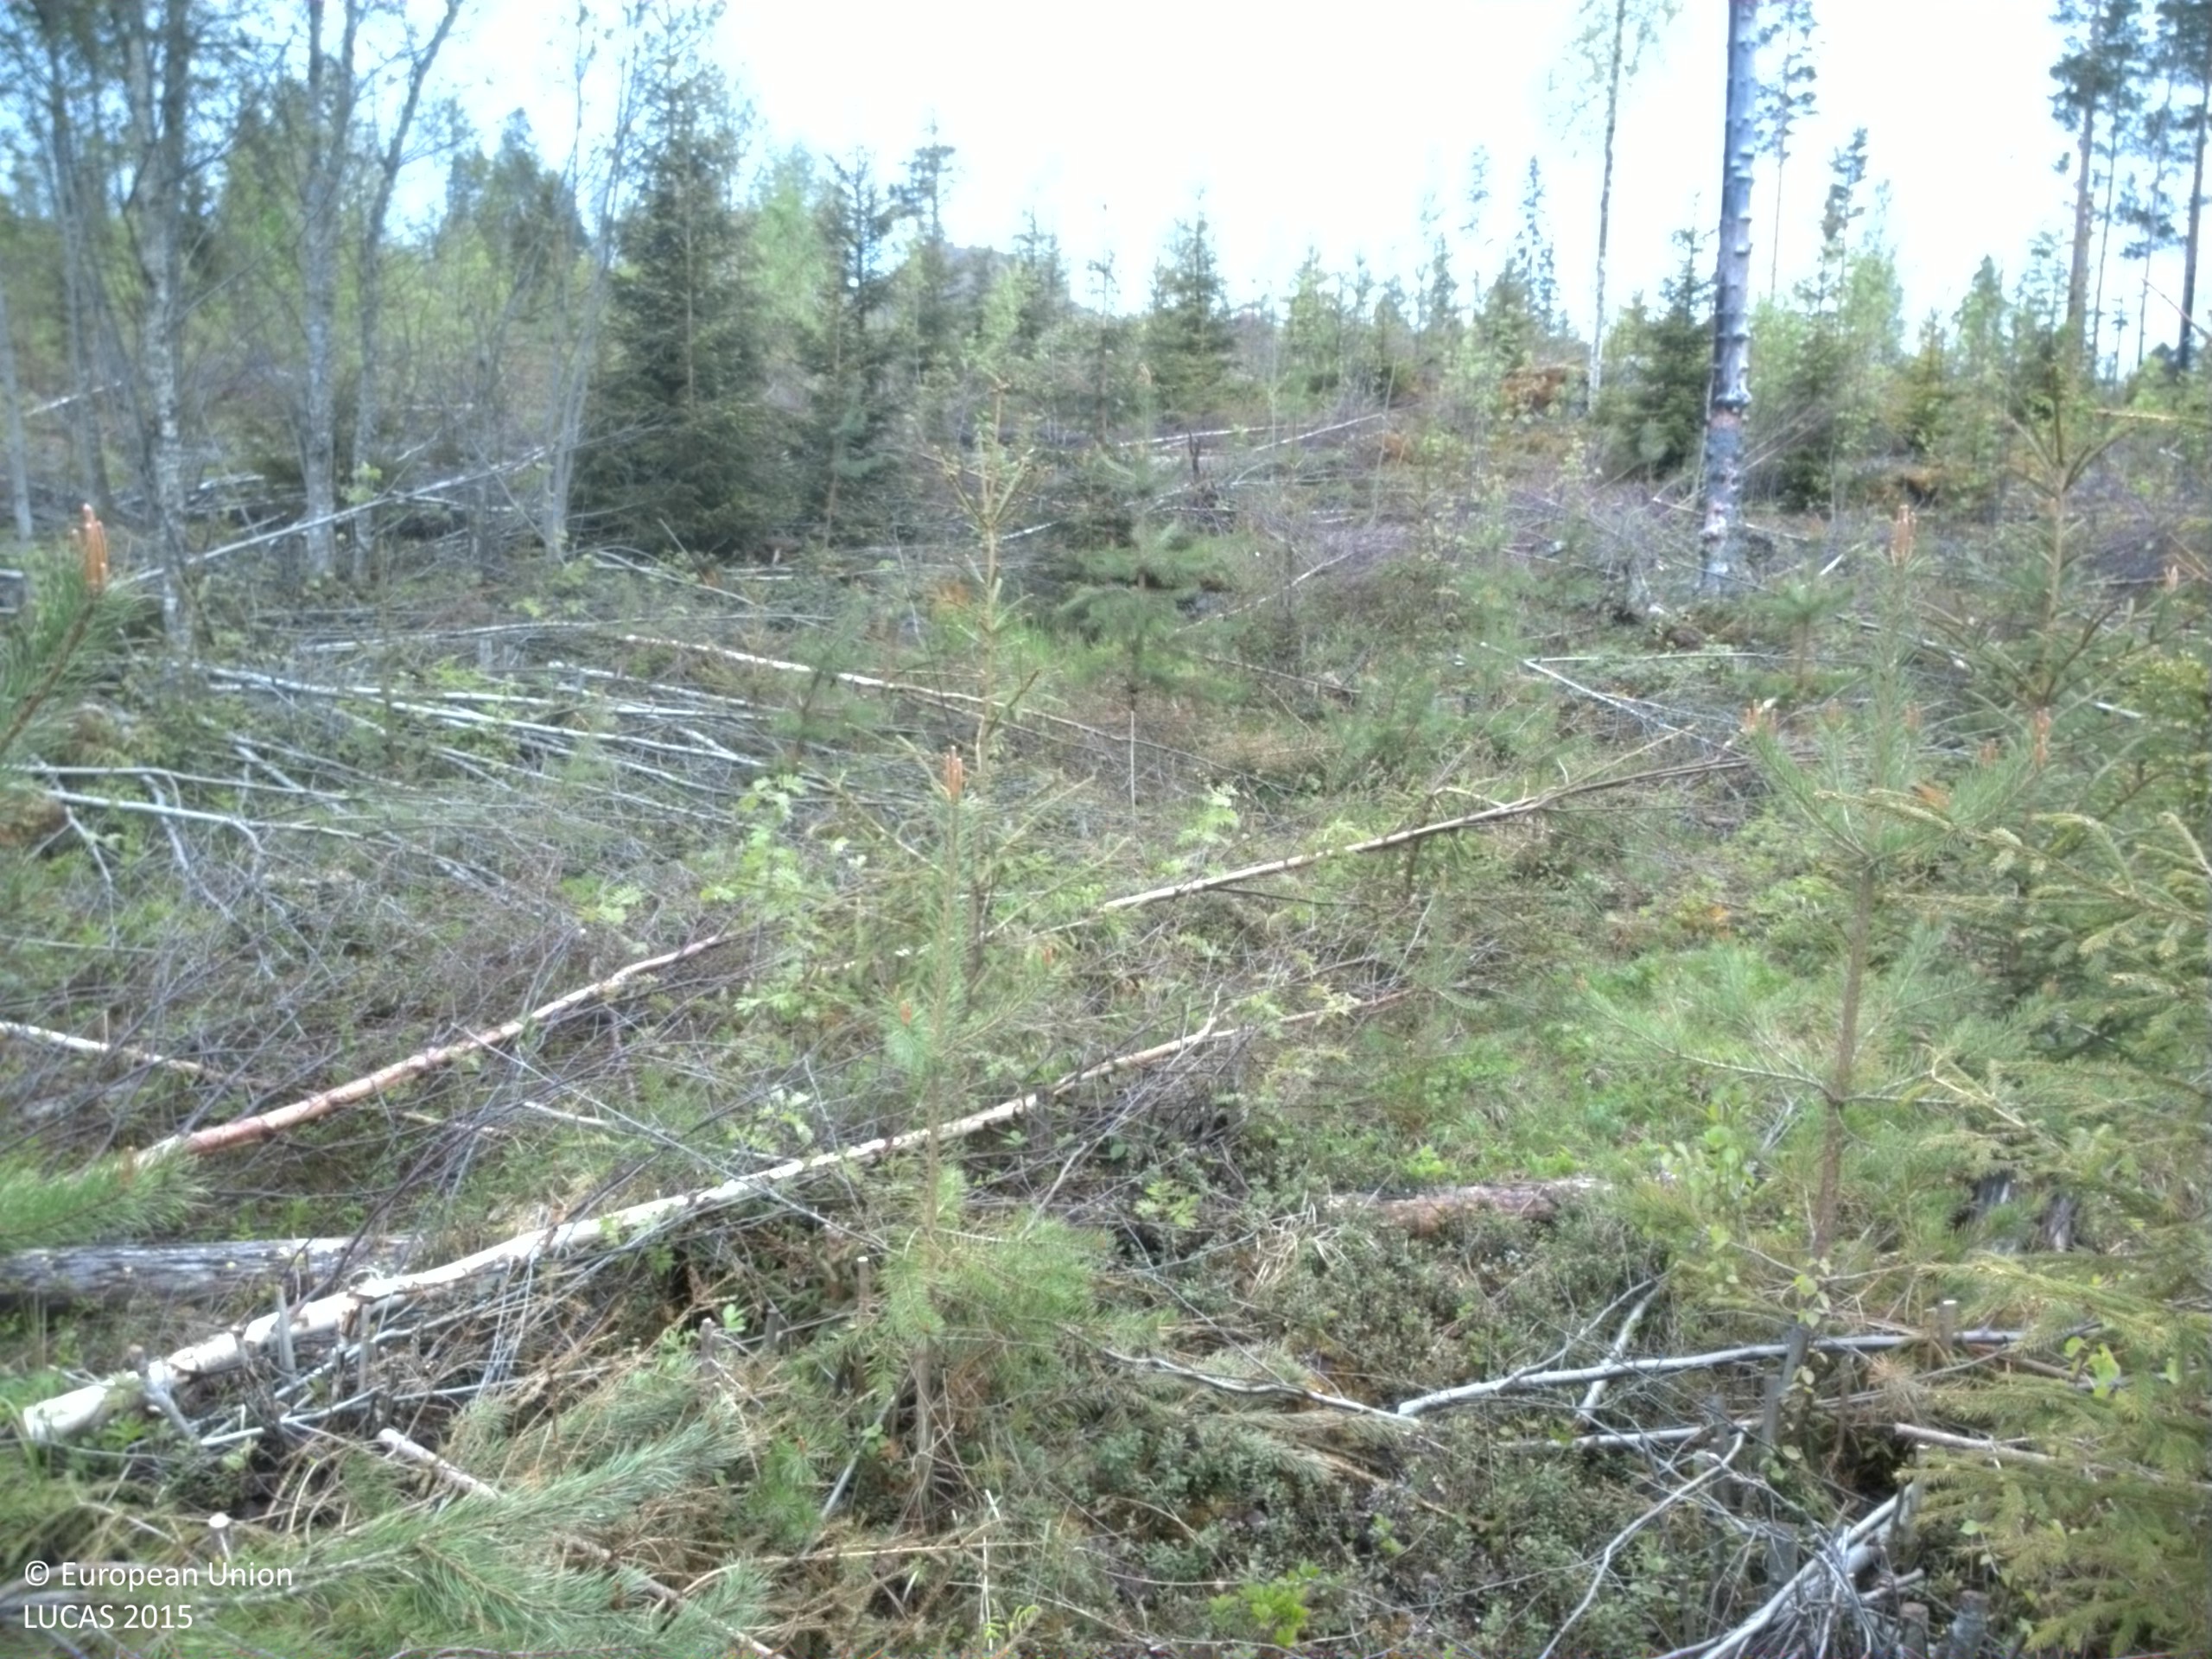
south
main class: Woodland
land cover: Other mixed woodland
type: boreal forest
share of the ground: > 75 %
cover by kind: coniferous forest trees 55 %, broadleaved forest trees 30 %, shrubs 15 %
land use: Forestry
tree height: < 5 m
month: June
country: SE
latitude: 63.1406
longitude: 16.9393
